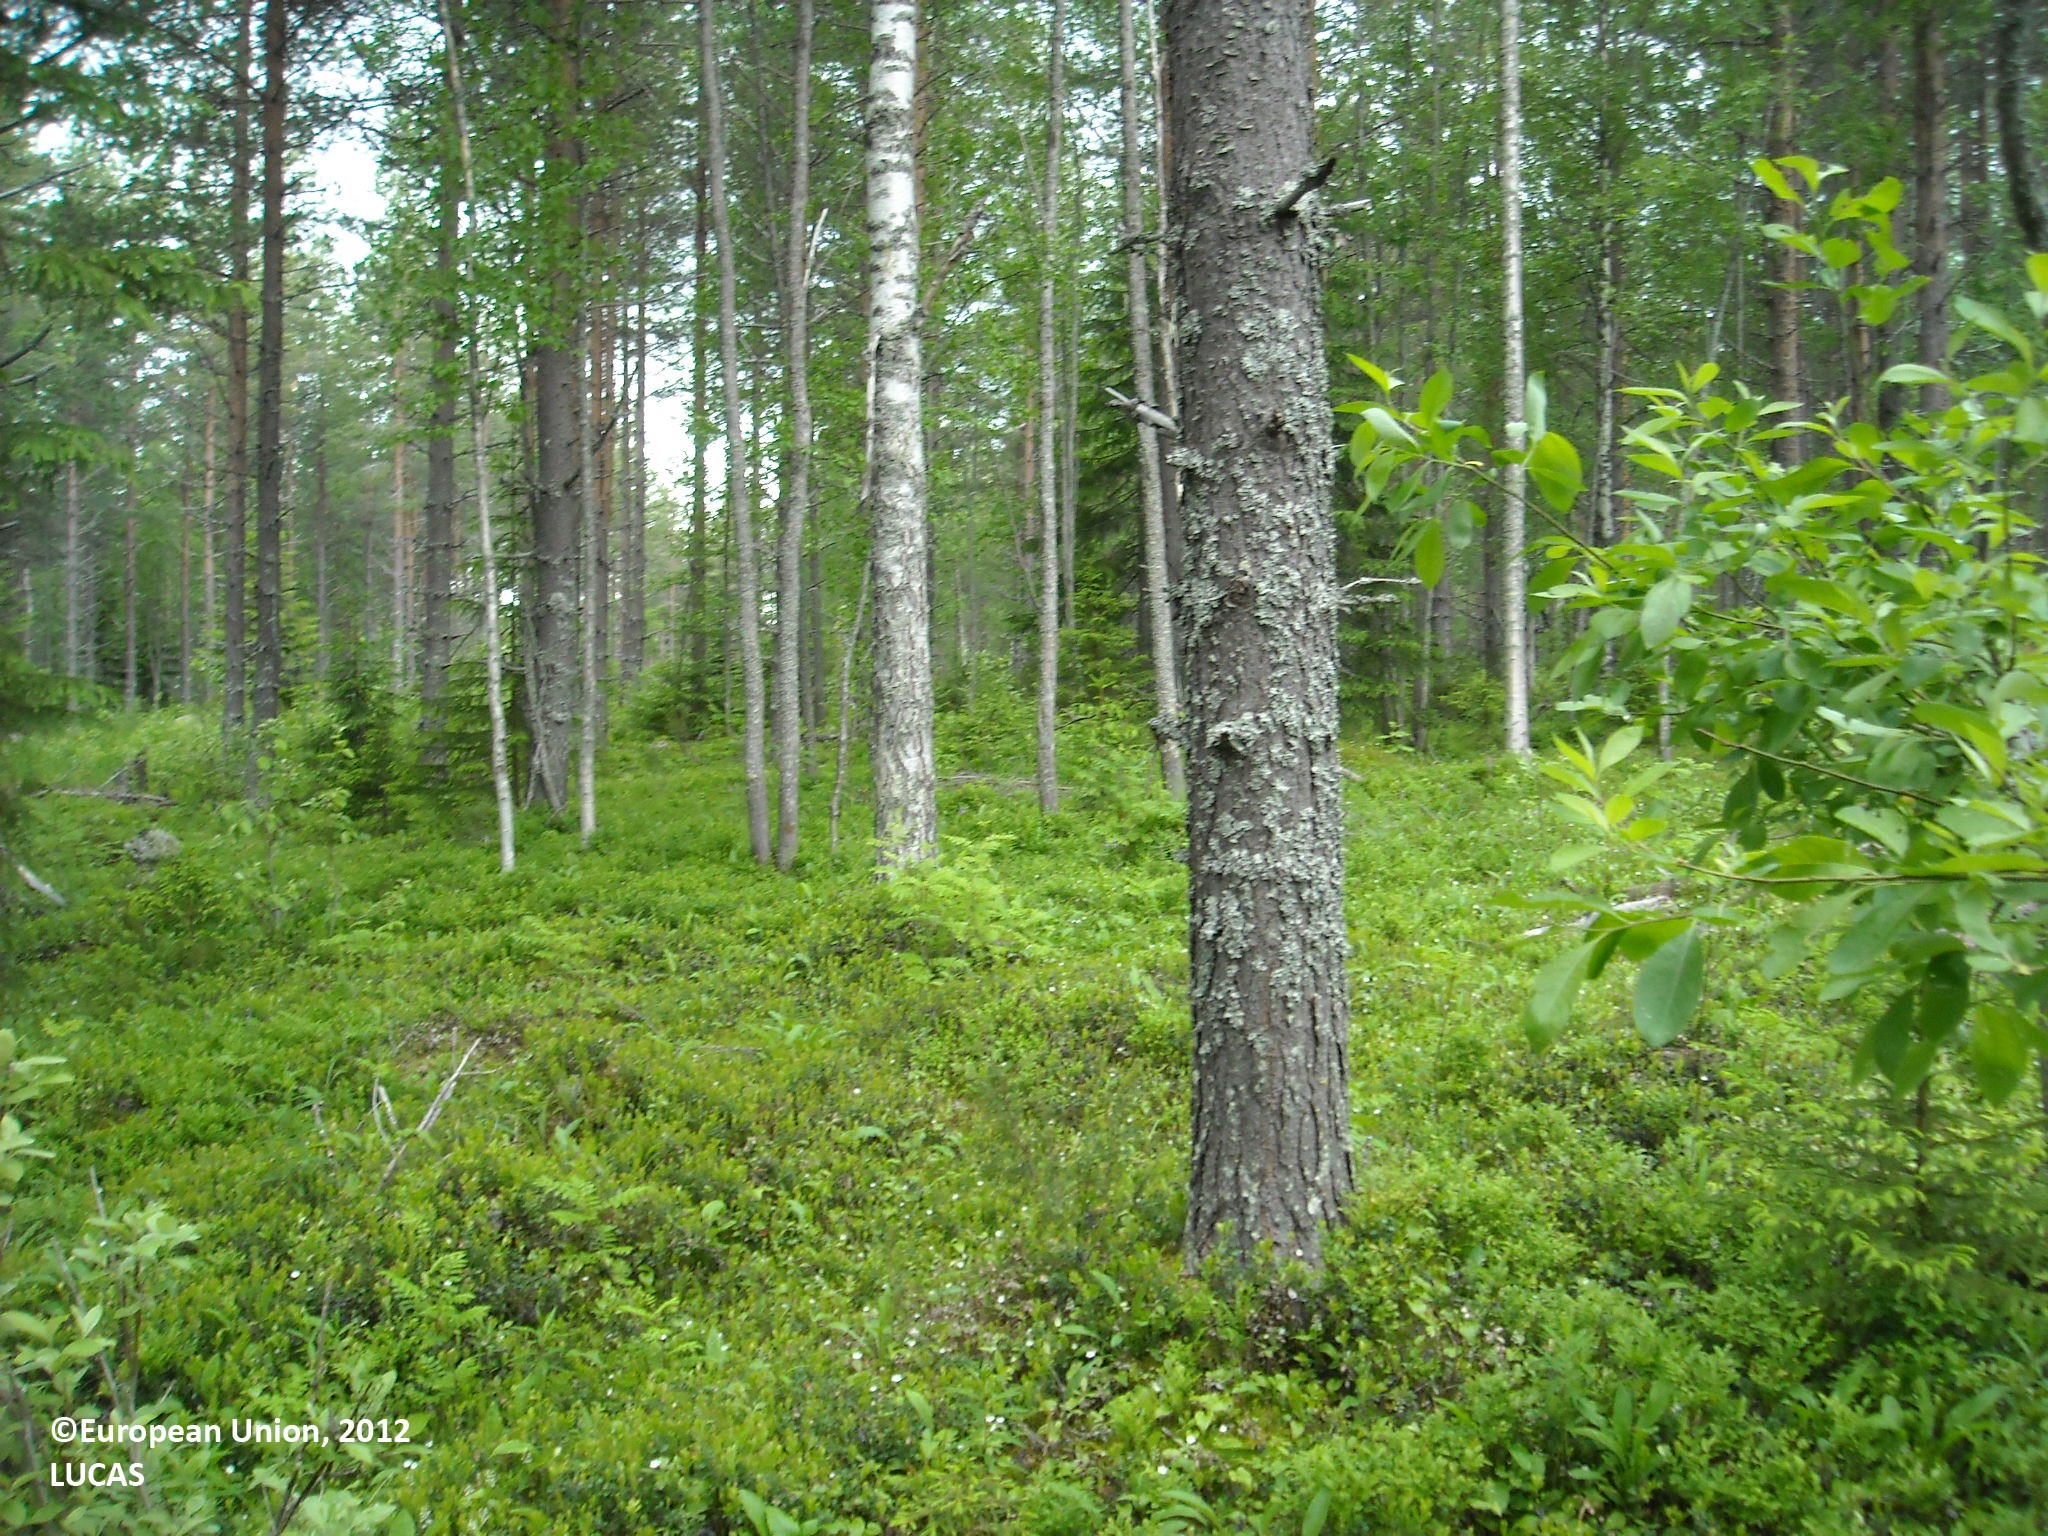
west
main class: Woodland
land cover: Pine dominated coniferous woodland
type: boreal forest
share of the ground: 25 - 50 %
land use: Forestry
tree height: > 5 m
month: June
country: FI
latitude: 64.7281
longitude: 27.8920
